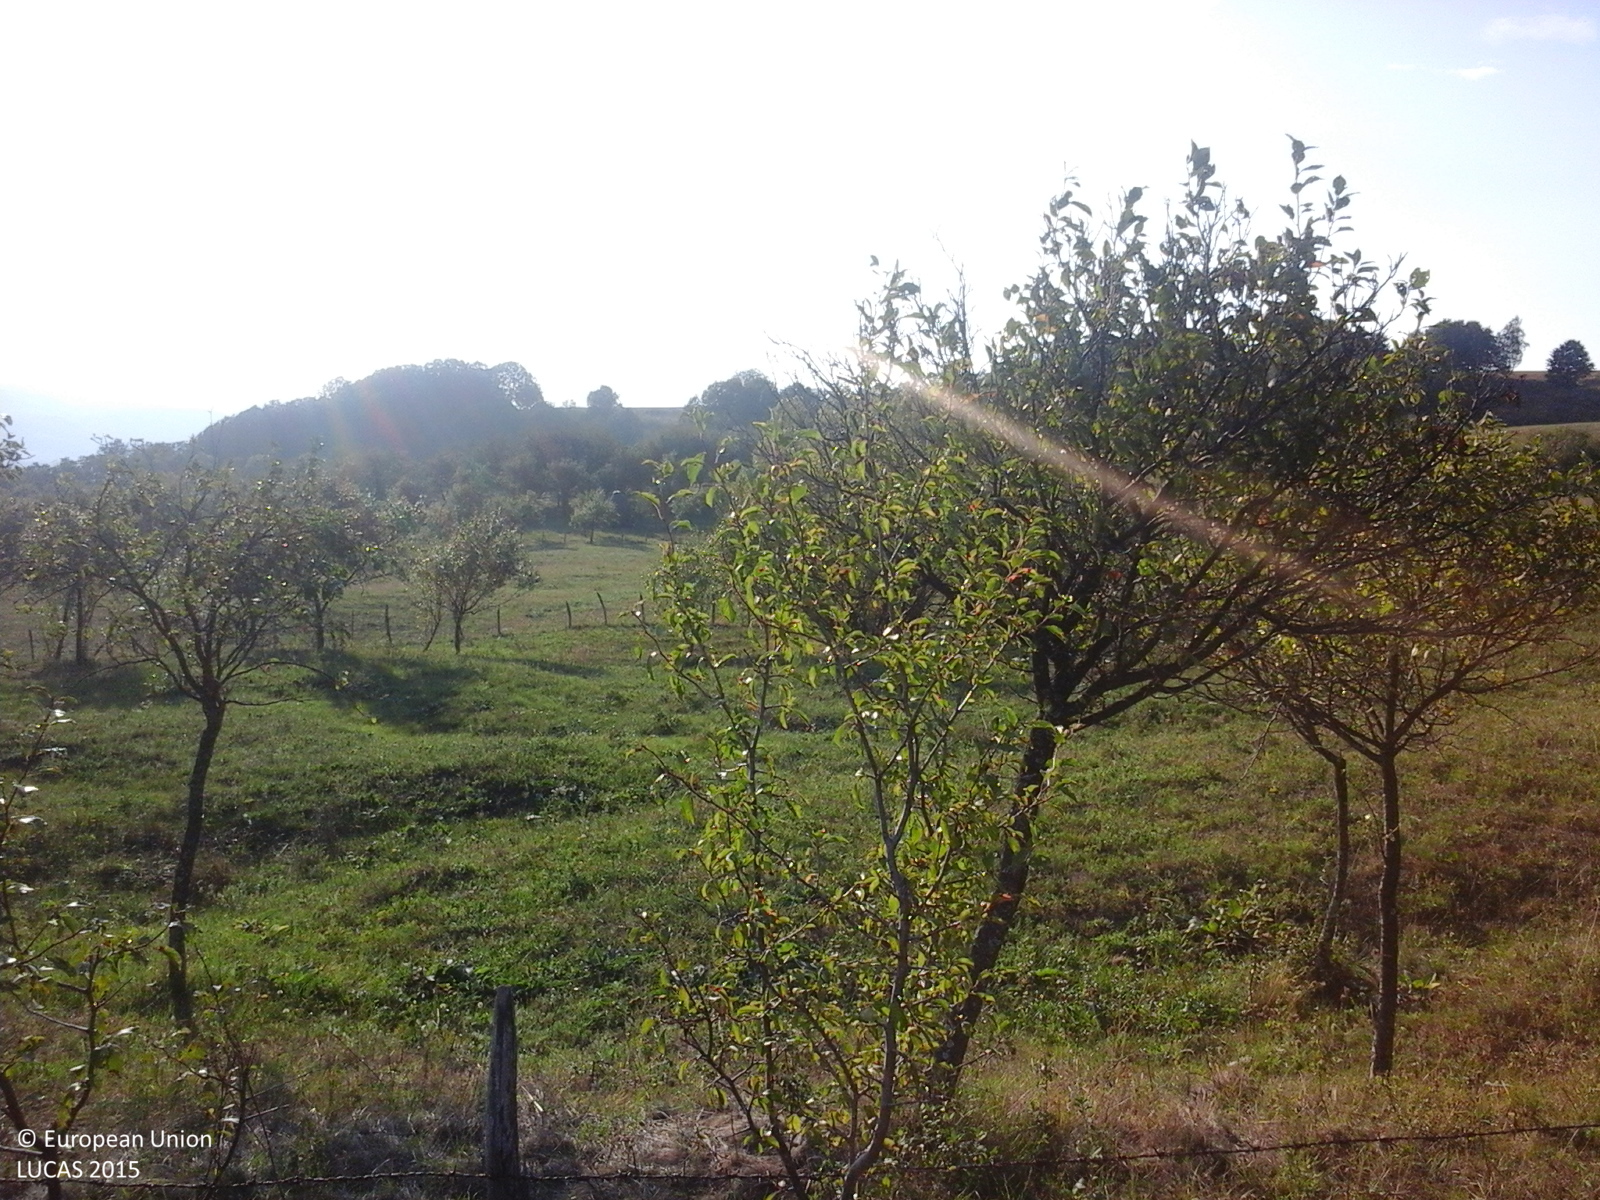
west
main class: Cropland
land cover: Other fruit trees and berries
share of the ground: 50 - 75 %
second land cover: Grassland without tree/shrub cover
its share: > 75 %
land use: Agriculture (excluding fallow land and kitchen gardens)
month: September
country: RO
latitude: 45.2898
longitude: 22.3200
